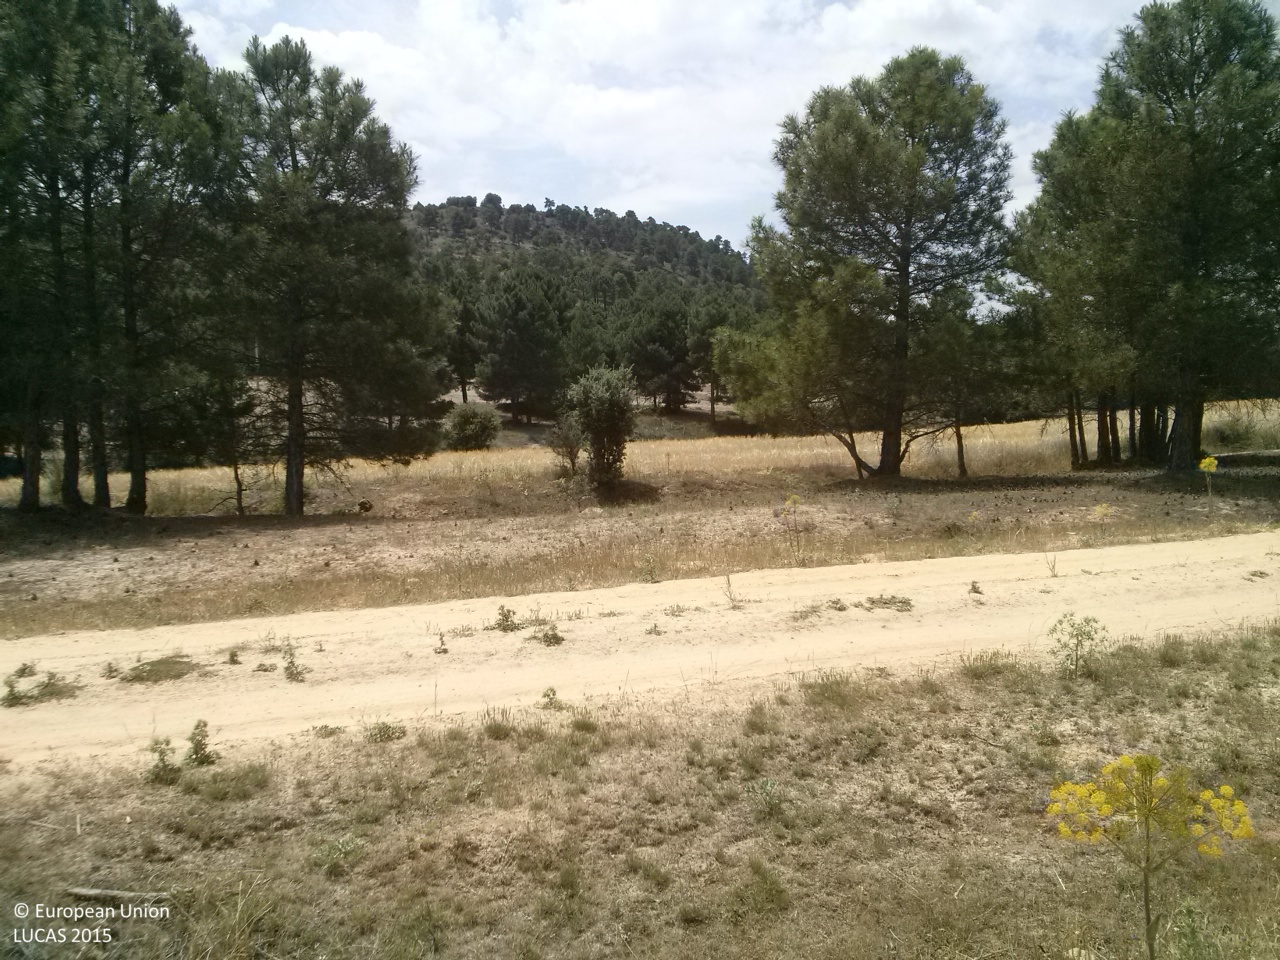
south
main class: Cropland
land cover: Sunflower
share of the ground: < 10 %
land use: Agriculture (excluding fallow land and kitchen gardens)
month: June
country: ES
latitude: 39.9573
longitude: -1.7759
